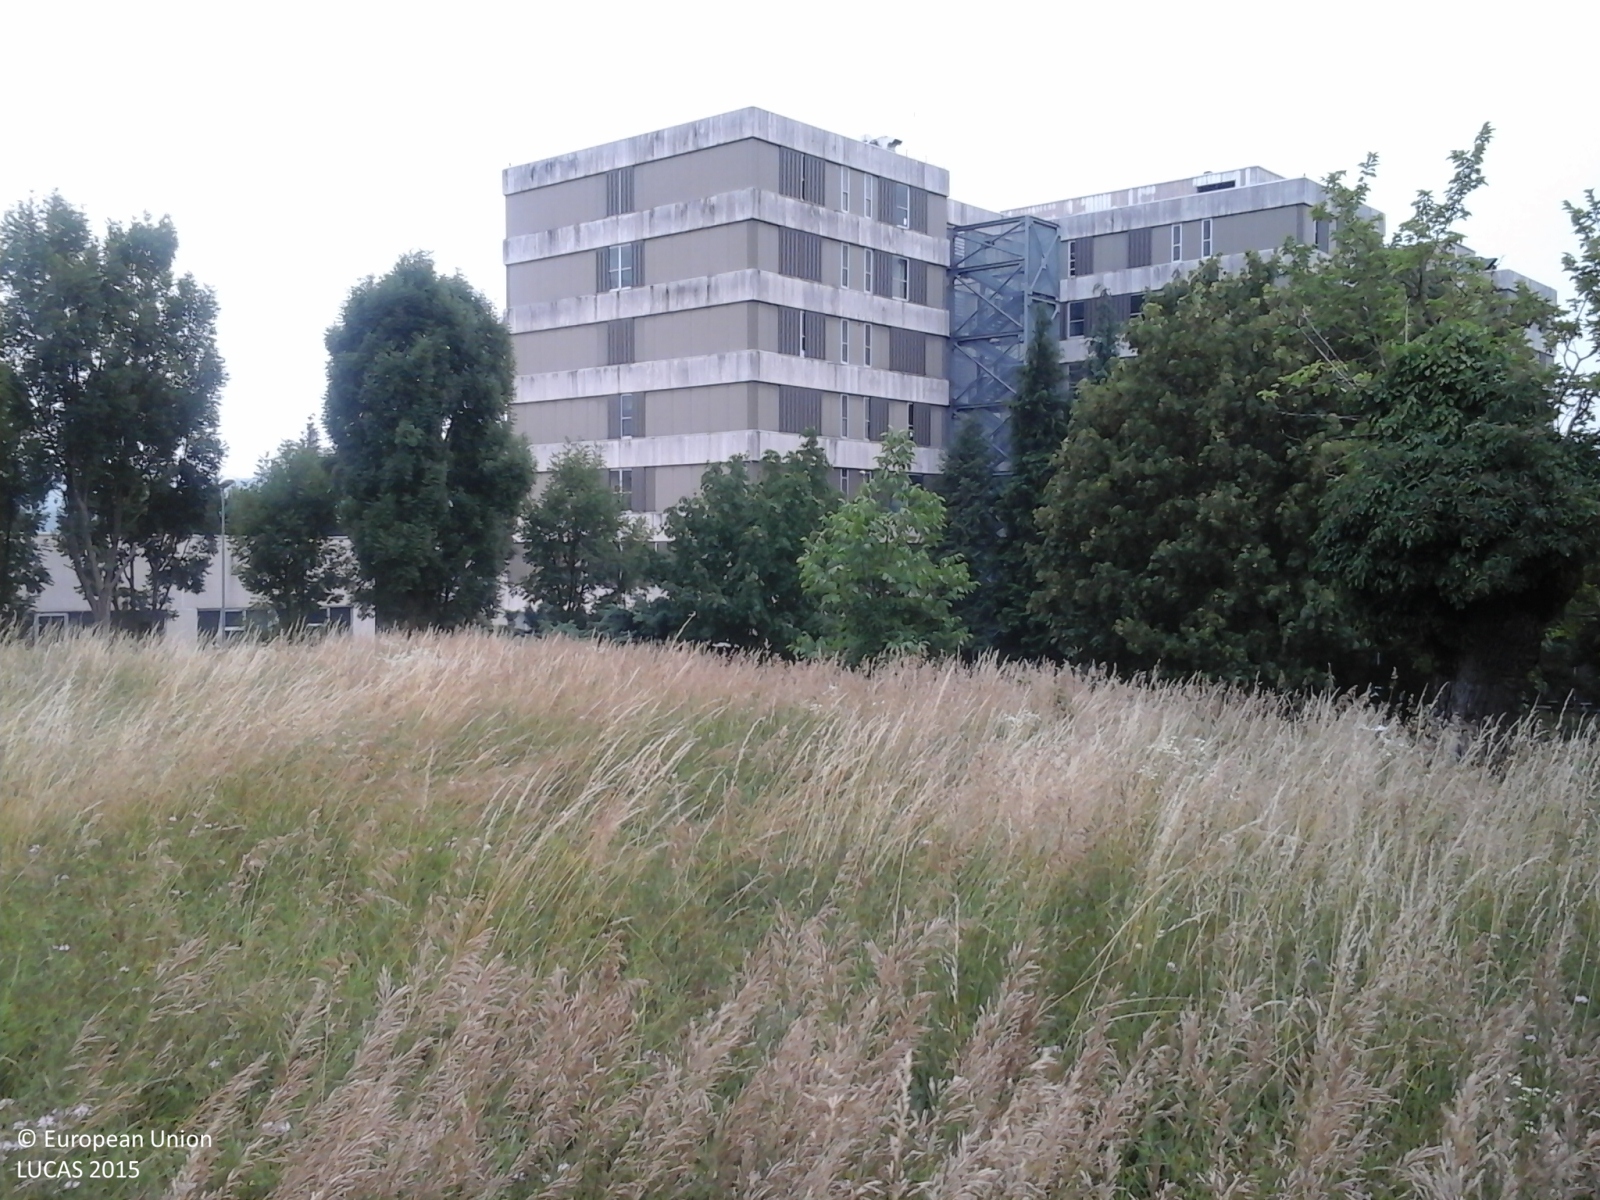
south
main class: Grassland
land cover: Grassland without tree/shrub cover
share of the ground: > 75 %
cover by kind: herbaceous plants 100 %
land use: Agriculture (excluding fallow land and kitchen gardens)
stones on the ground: < 10 %
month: July
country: IT
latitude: 44.6817
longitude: 8.4514
